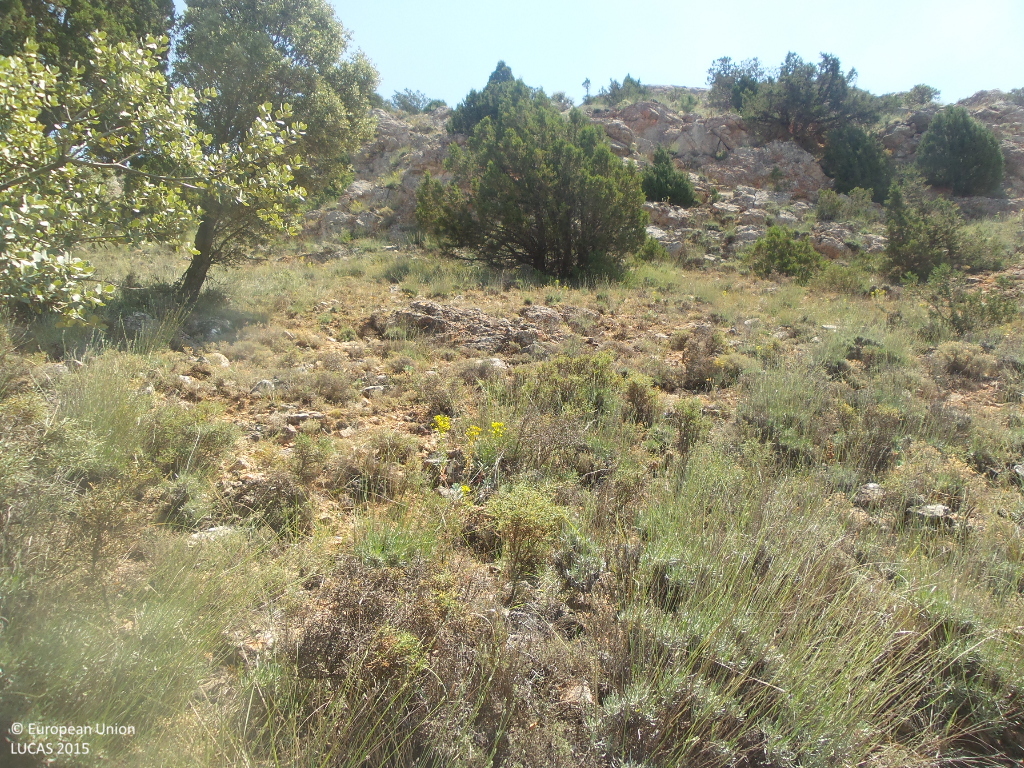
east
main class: Woodland
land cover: Other mixed woodland
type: coniferous forest of the mediterranean region
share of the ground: 25 - 50 %
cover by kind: unconsolidated bare surface 40 %, shrubs 25 %, coniferous forest trees 20 %, broadleaved forest trees 10 %, herbaceous plants 5 %
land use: Semi-natural and natural areas not in use
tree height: > 5 m
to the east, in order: Other mixed woodland
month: July
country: ES
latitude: 41.1329
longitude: -2.1668
